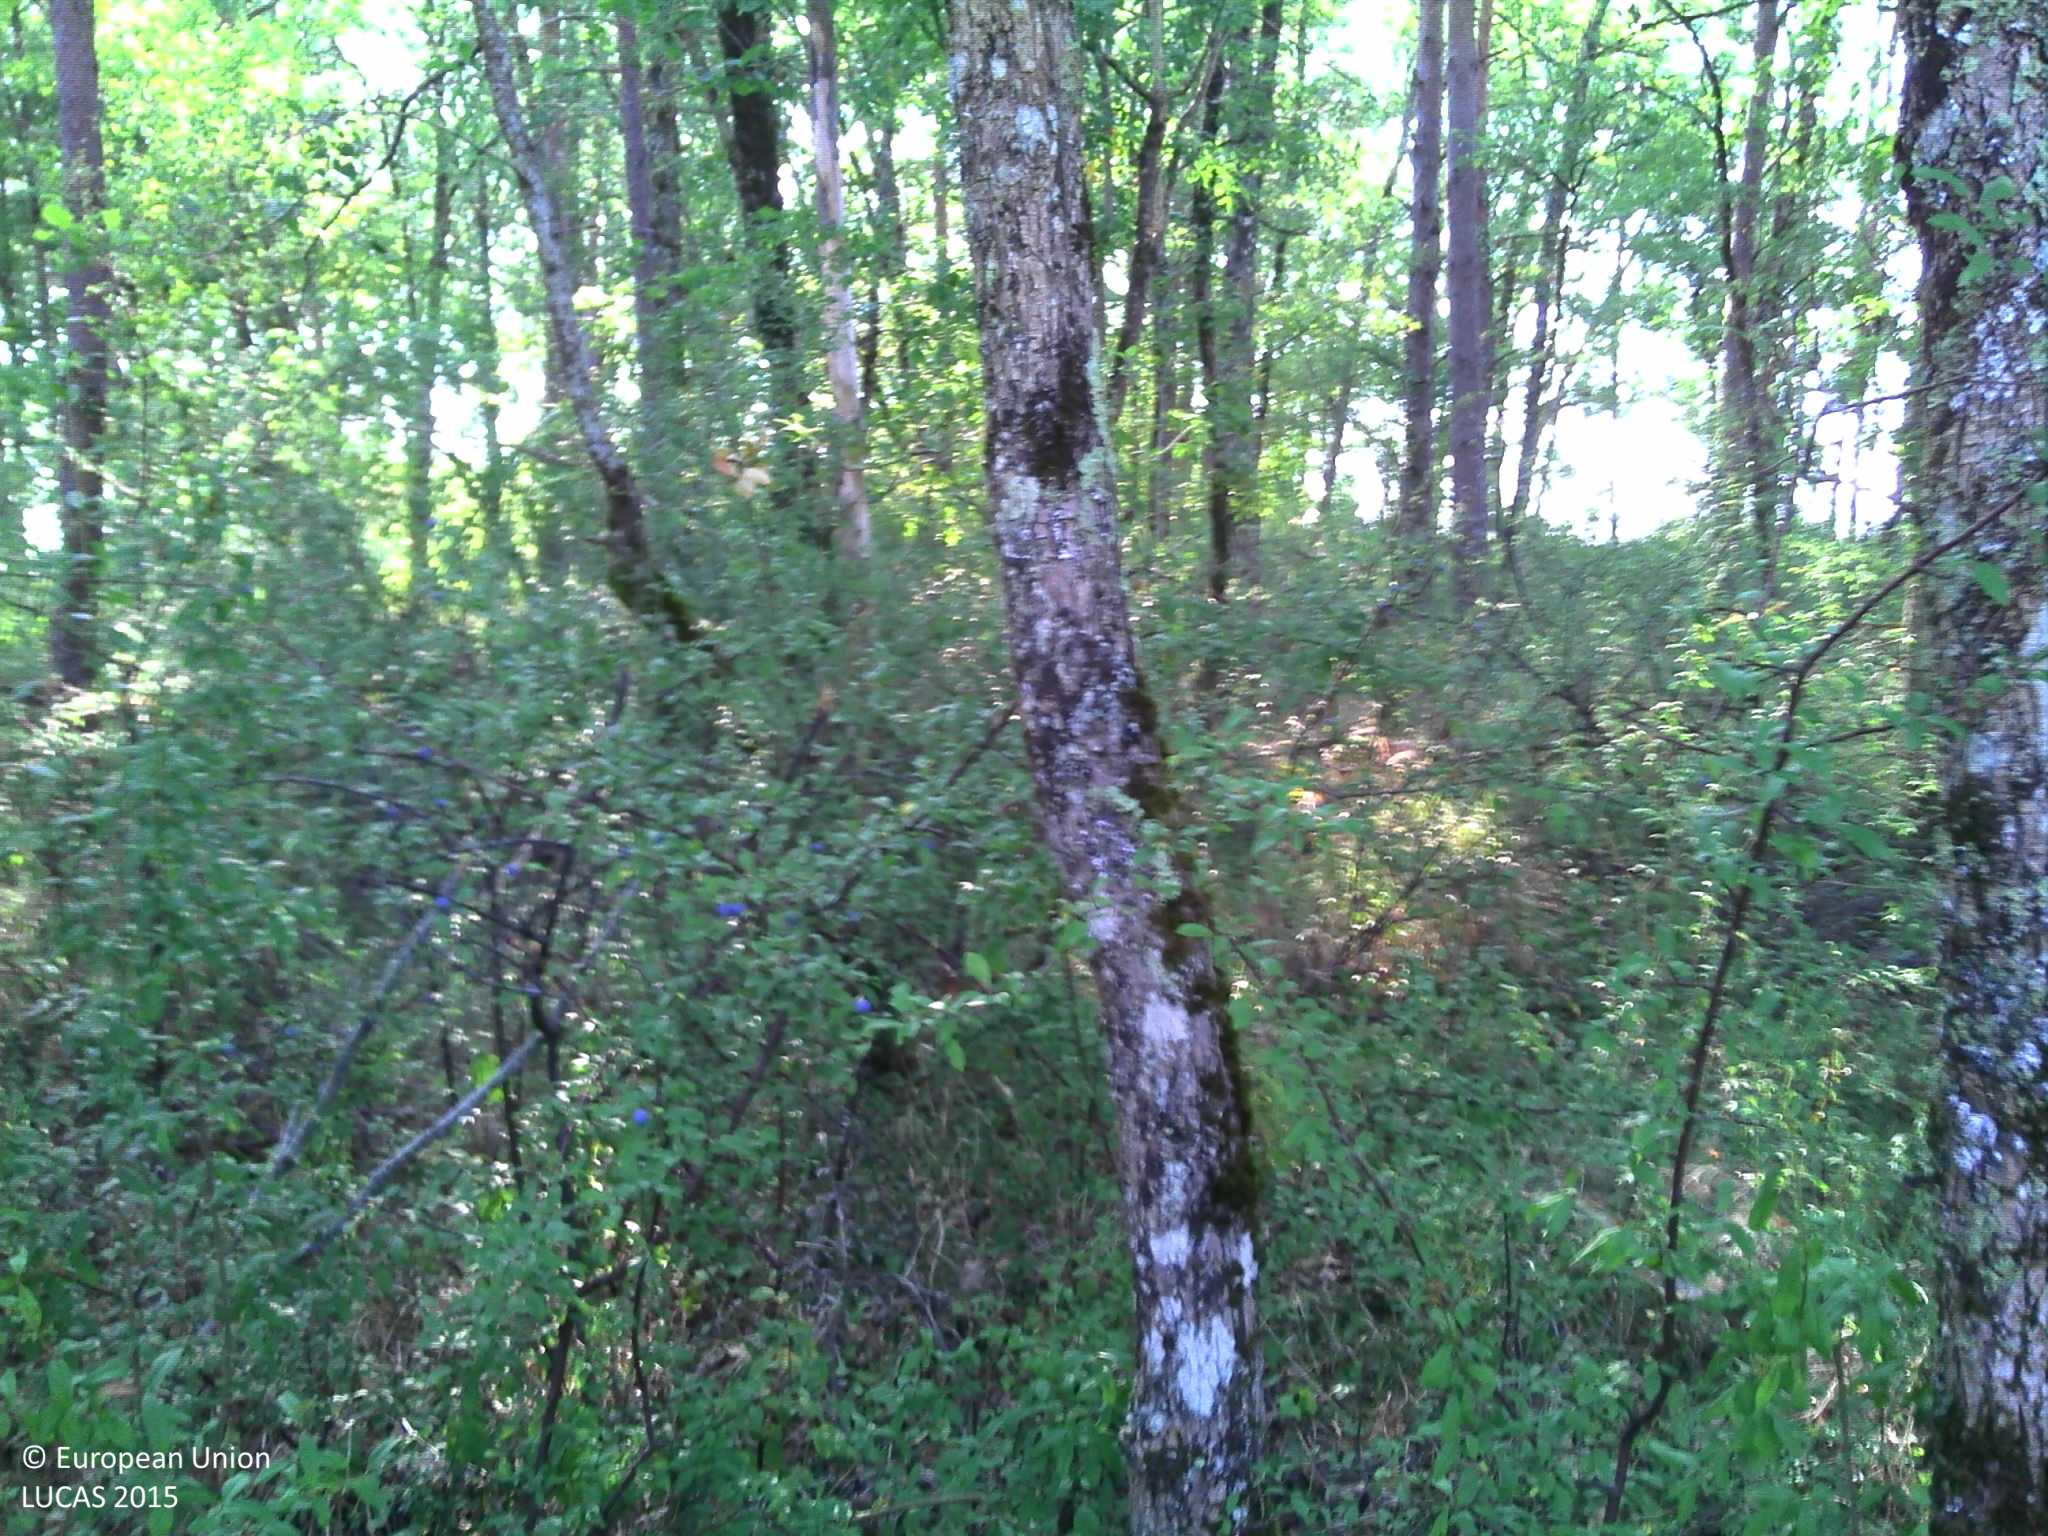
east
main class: Woodland
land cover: Broadleaved woodland
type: acidophilous oak and oak-birch forest
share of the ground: > 75 %
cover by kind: broadleaved forest trees 75 %, herbaceous plants 15 %, coniferous forest trees 5 %, shrubs 5 %
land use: Forestry
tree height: > 5 m
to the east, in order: Broadleaved woodland; Spontaneously vegetated surfaces; Broadleaved woodland; Fences; Grassland without tree/shrub cover
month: July
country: FR
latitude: 45.2514
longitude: 1.0602
